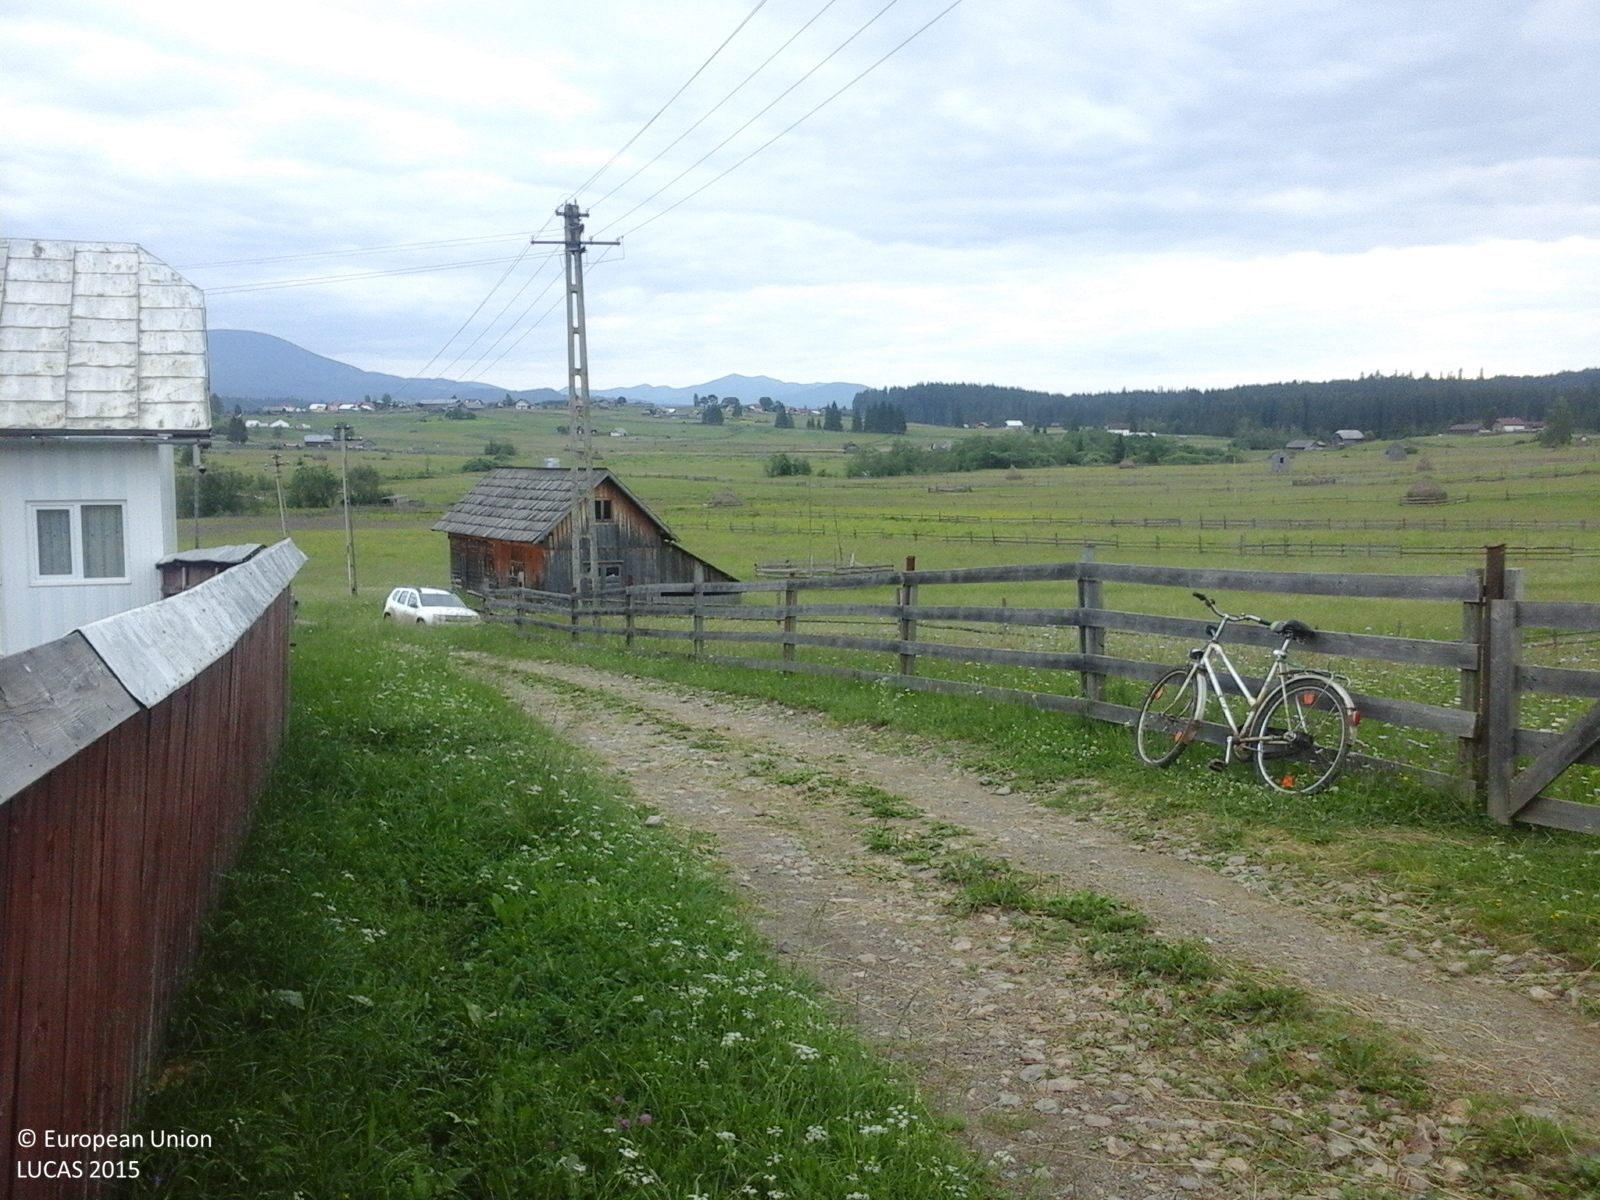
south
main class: Grassland
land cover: Grassland without tree/shrub cover
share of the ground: > 75 %
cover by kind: herbaceous plants 100 %
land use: Agriculture (excluding fallow land and kitchen gardens)
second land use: Residential
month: June
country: RO
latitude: 47.3366
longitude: 25.1271
